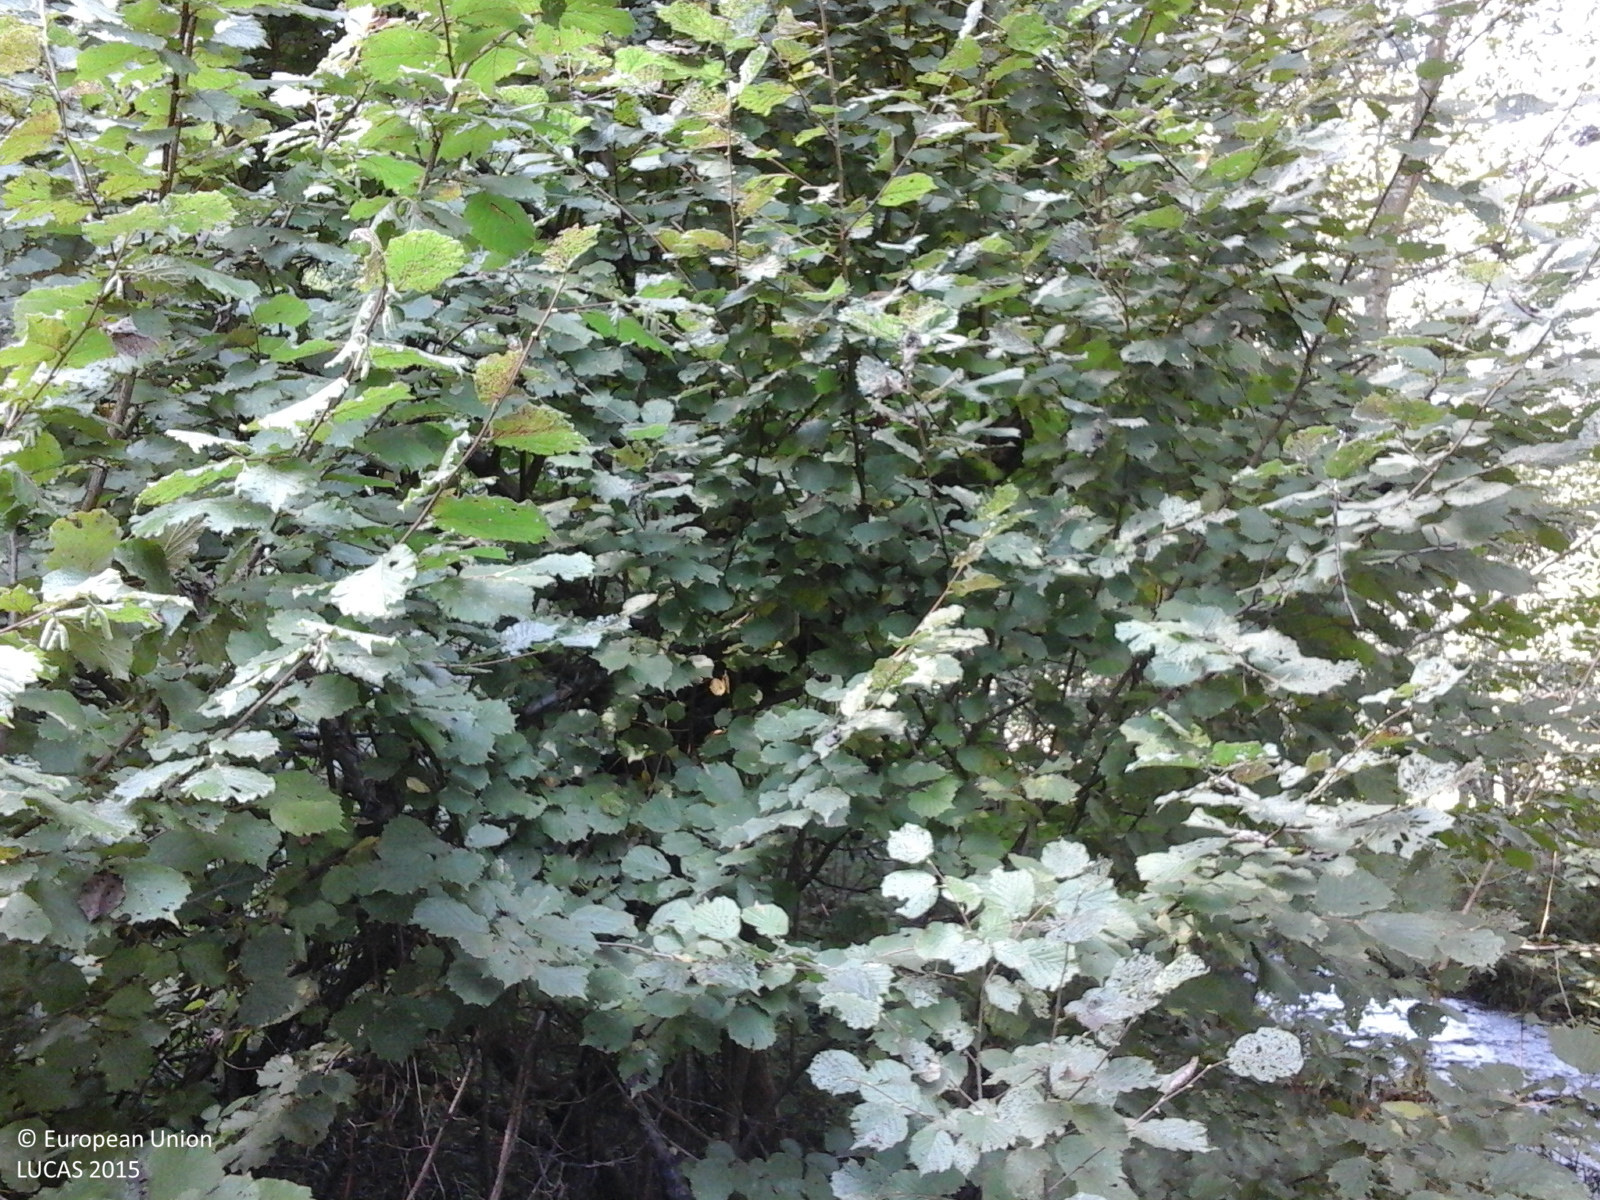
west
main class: Woodland
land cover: Broadleaved woodland
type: beech forest
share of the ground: > 75 %
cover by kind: broadleaved forest trees 100 %
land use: Forestry
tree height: > 5 m
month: September
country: RO
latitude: 45.5906
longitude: 22.7005
